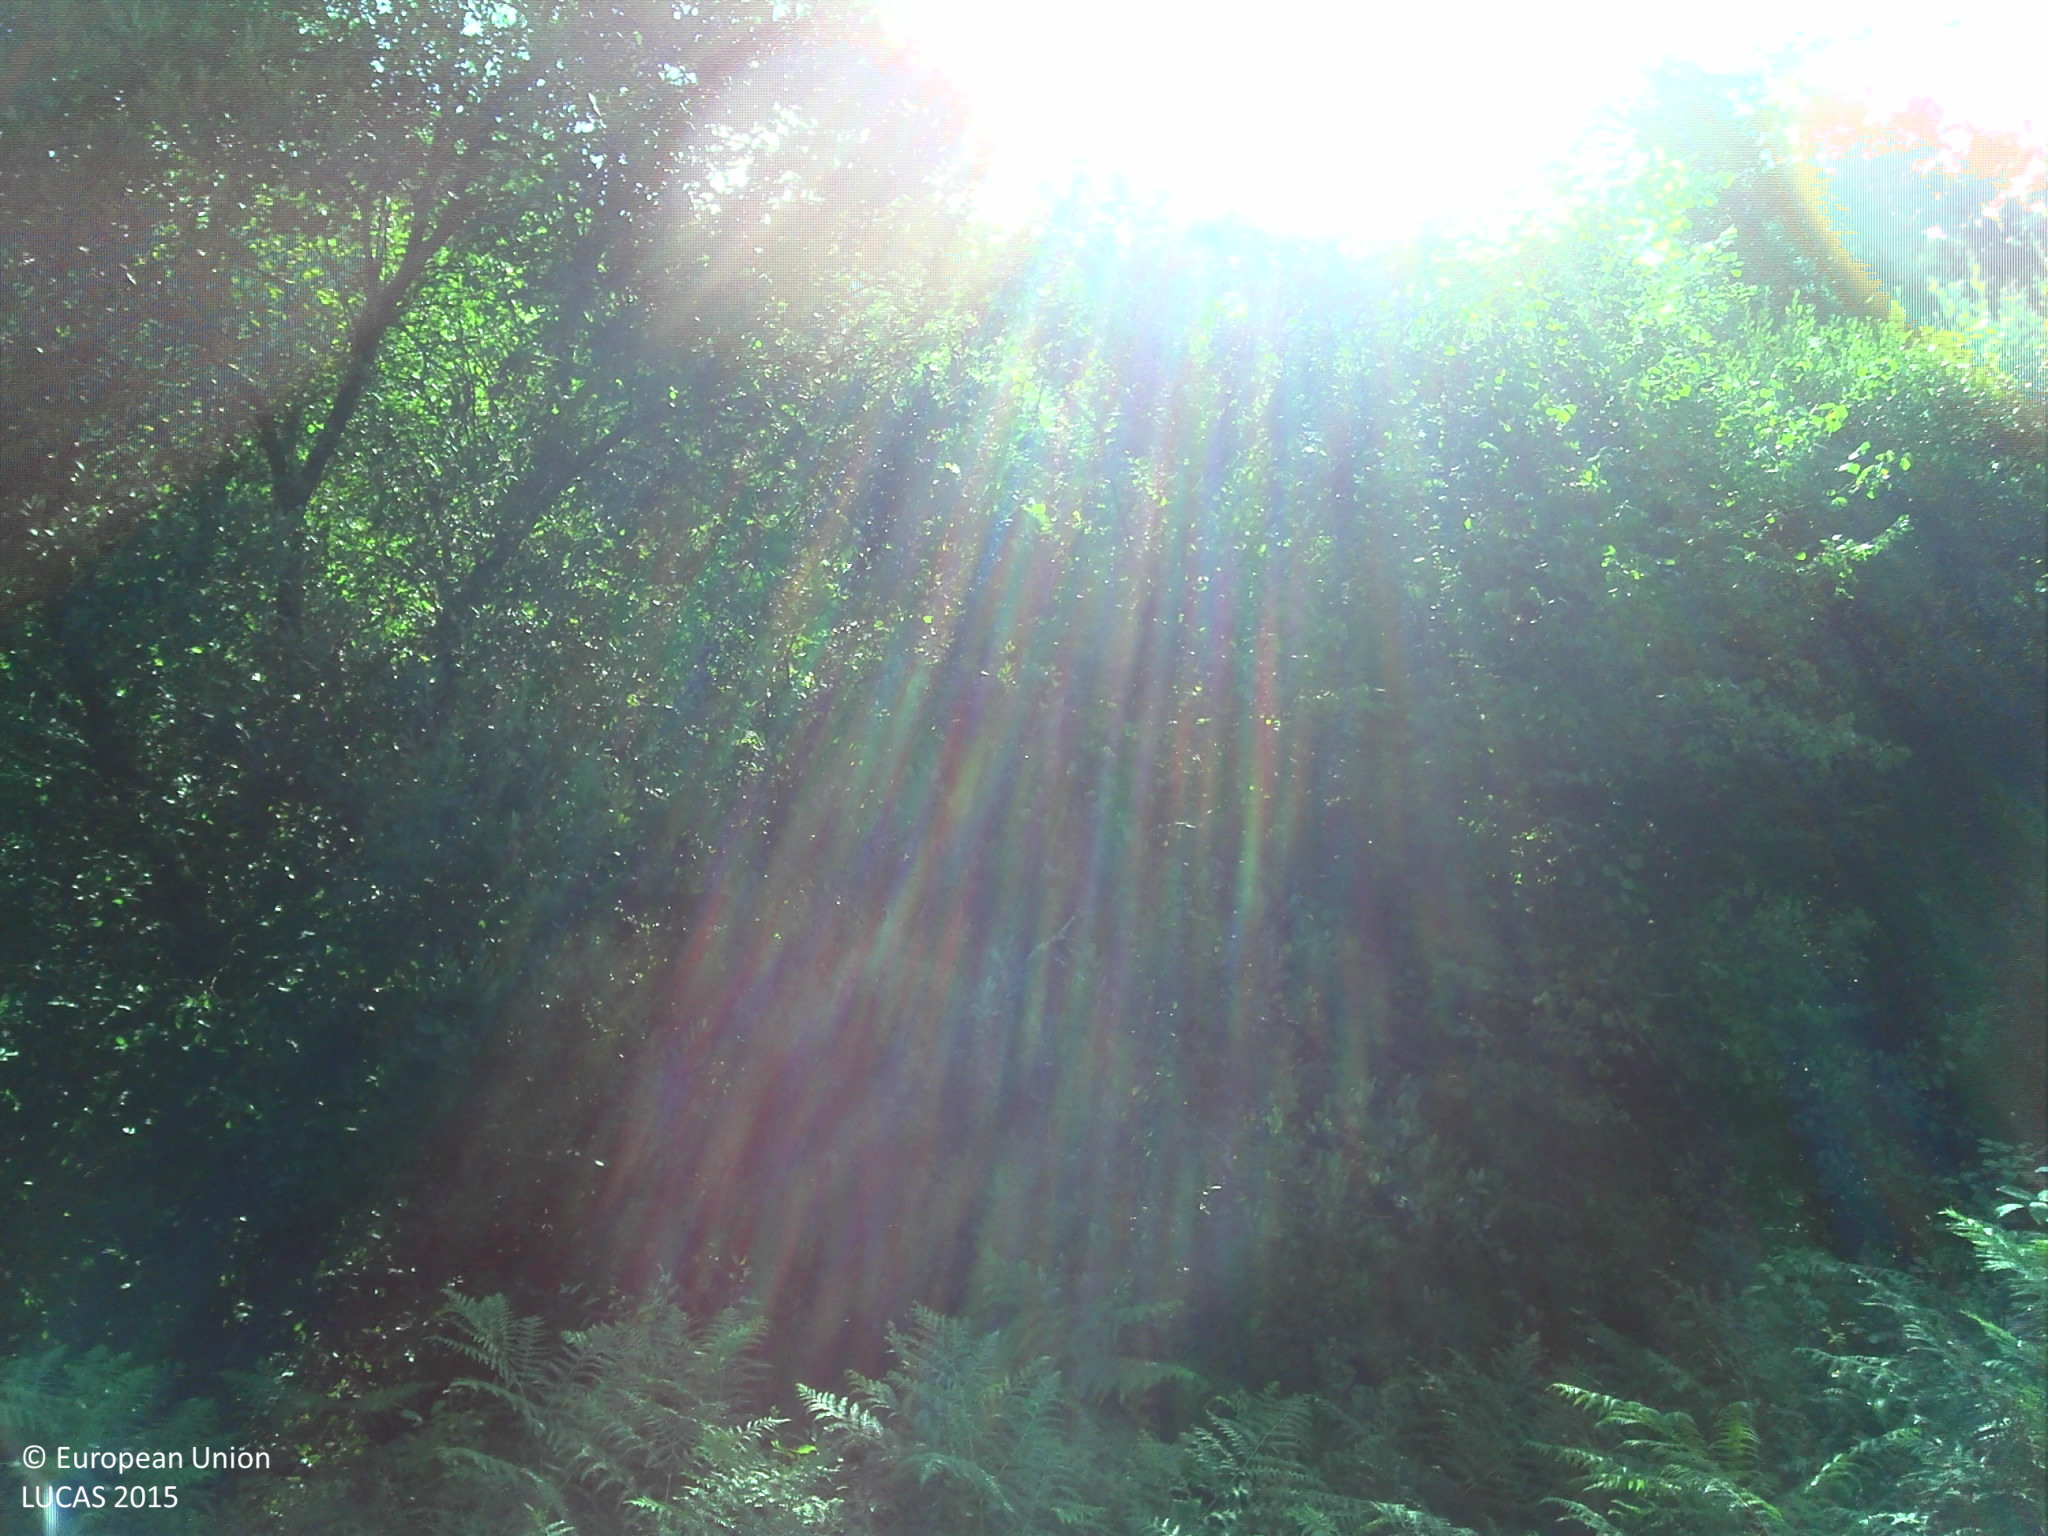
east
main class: Grassland
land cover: Spontaneously vegetated surfaces
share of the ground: > 75 %
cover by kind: herbaceous plants 95 %, shrubs 5 %
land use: Forestry
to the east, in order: Spontaneously vegetated surfaces; Broadleaved woodland; Rivers and streams; Broadleaved woodland
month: August
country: FR
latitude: 43.4717
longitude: -1.1778
